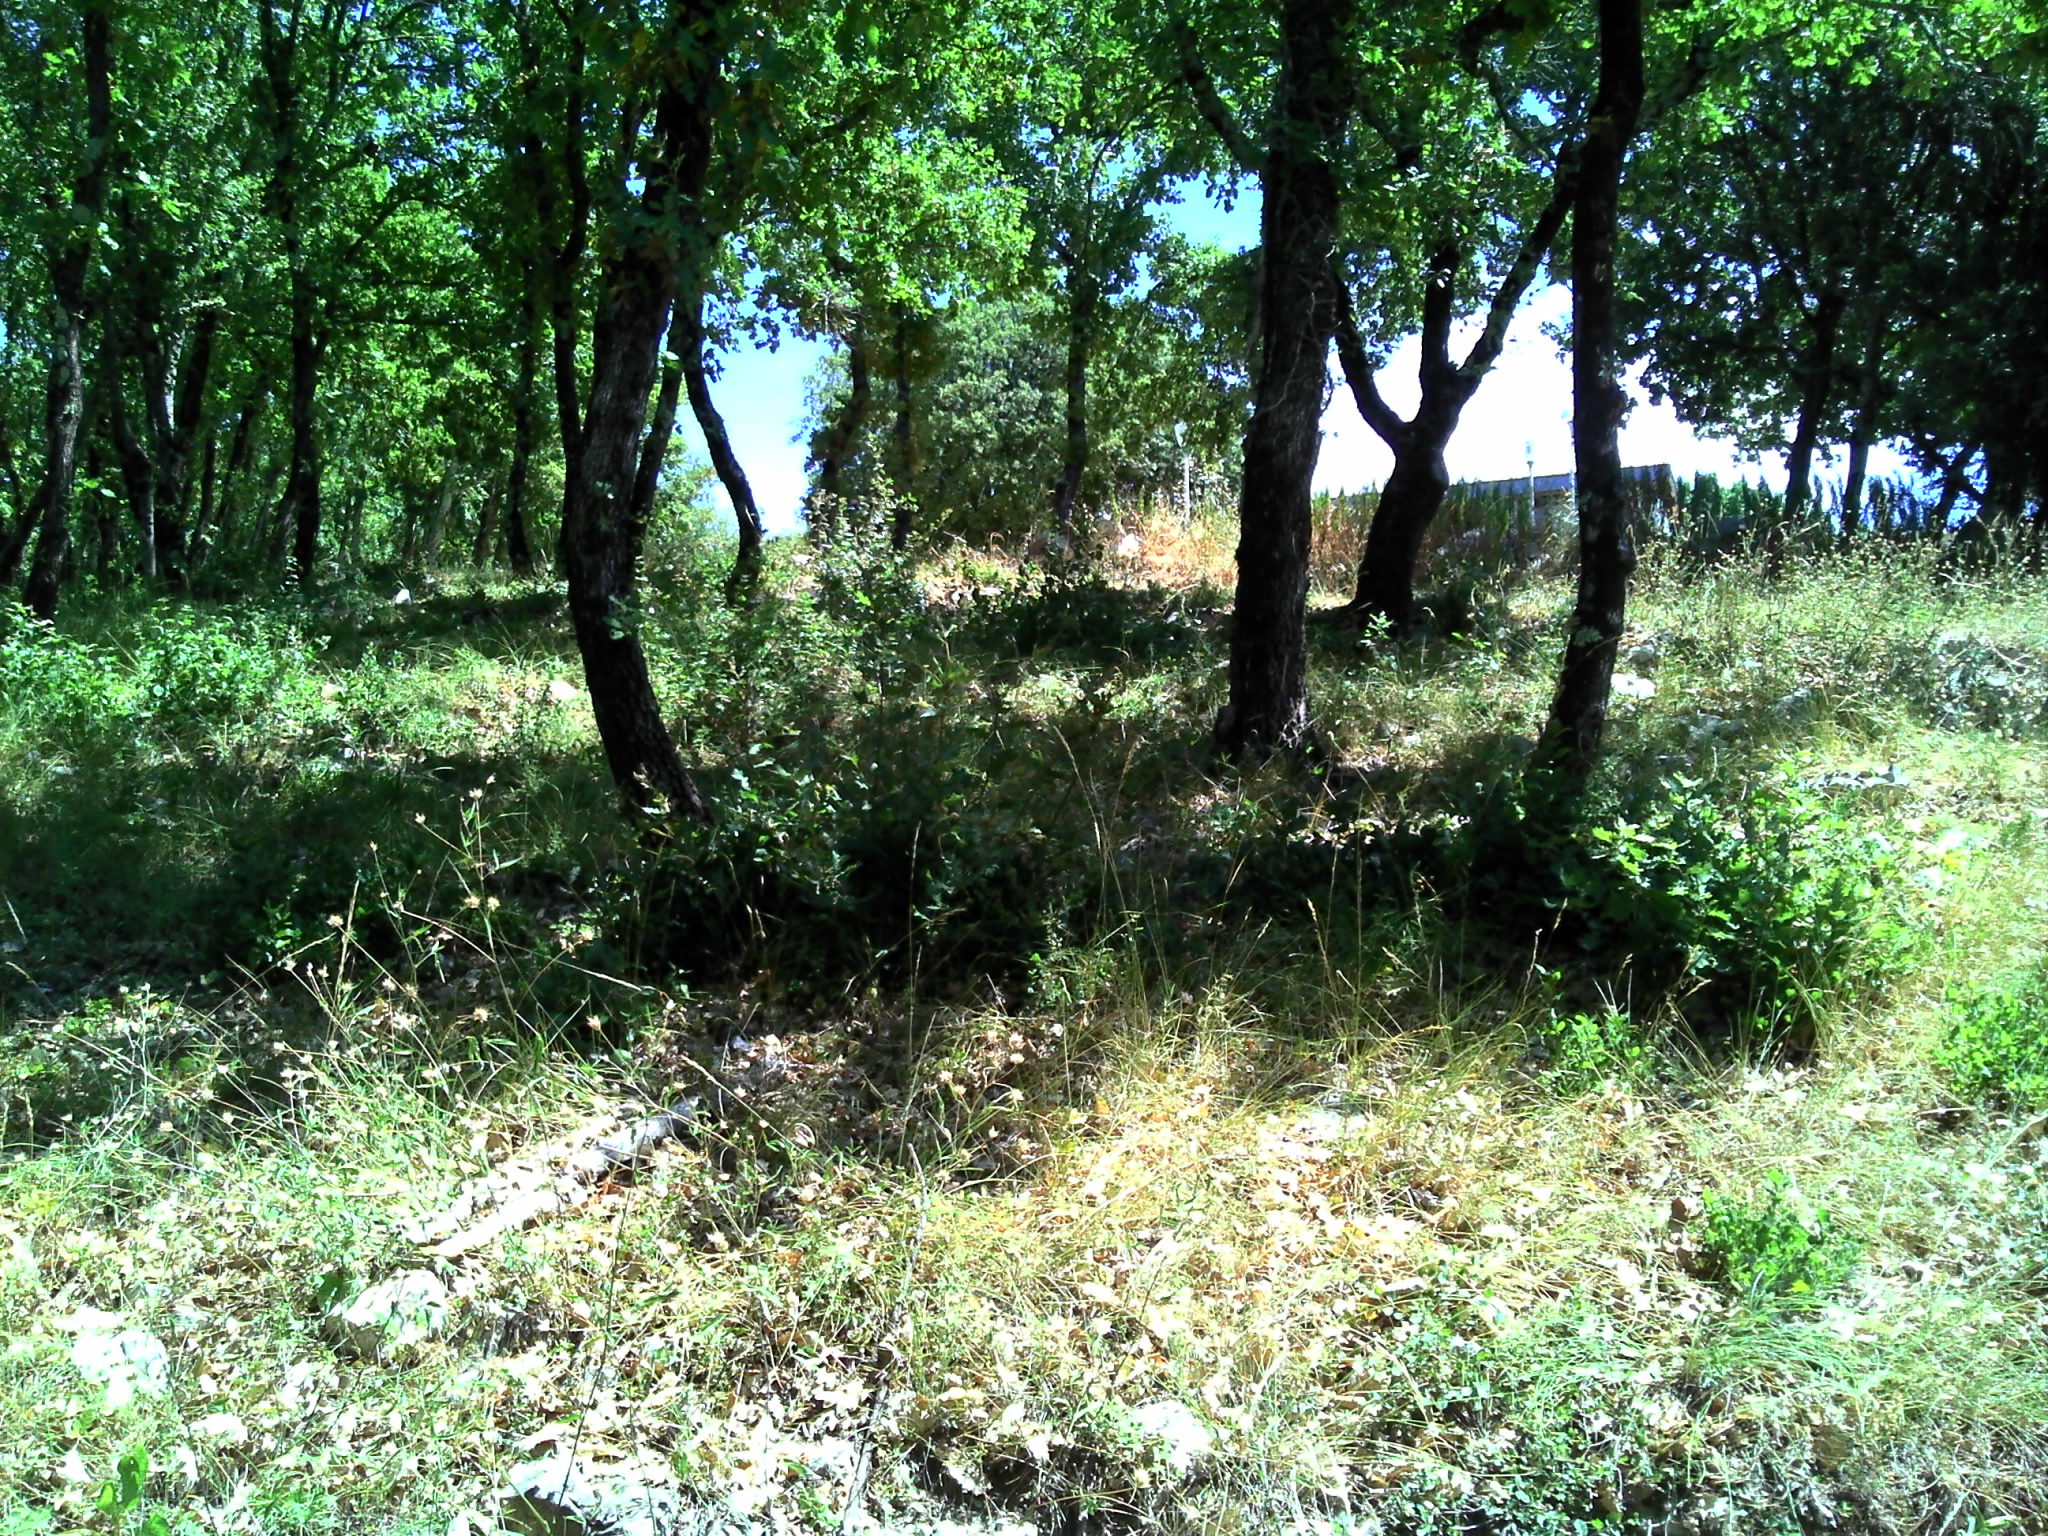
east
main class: Woodland
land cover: Broadleaved woodland
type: acidophilous oak and oak-birch forest
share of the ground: > 75 %
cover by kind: broadleaved forest trees 70 %, herbaceous plants 15 %, consolidated bare surface 15 %
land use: Semi-natural and natural areas not in use
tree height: > 5 m
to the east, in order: Broadleaved woodland; Tracks; Broadleaved woodland; Fences; Tracks; Broadleaved woodland; Artificial constructions in urban areas; Broadleaved woodland
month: July
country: FR
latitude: 44.1753
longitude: 4.2915
